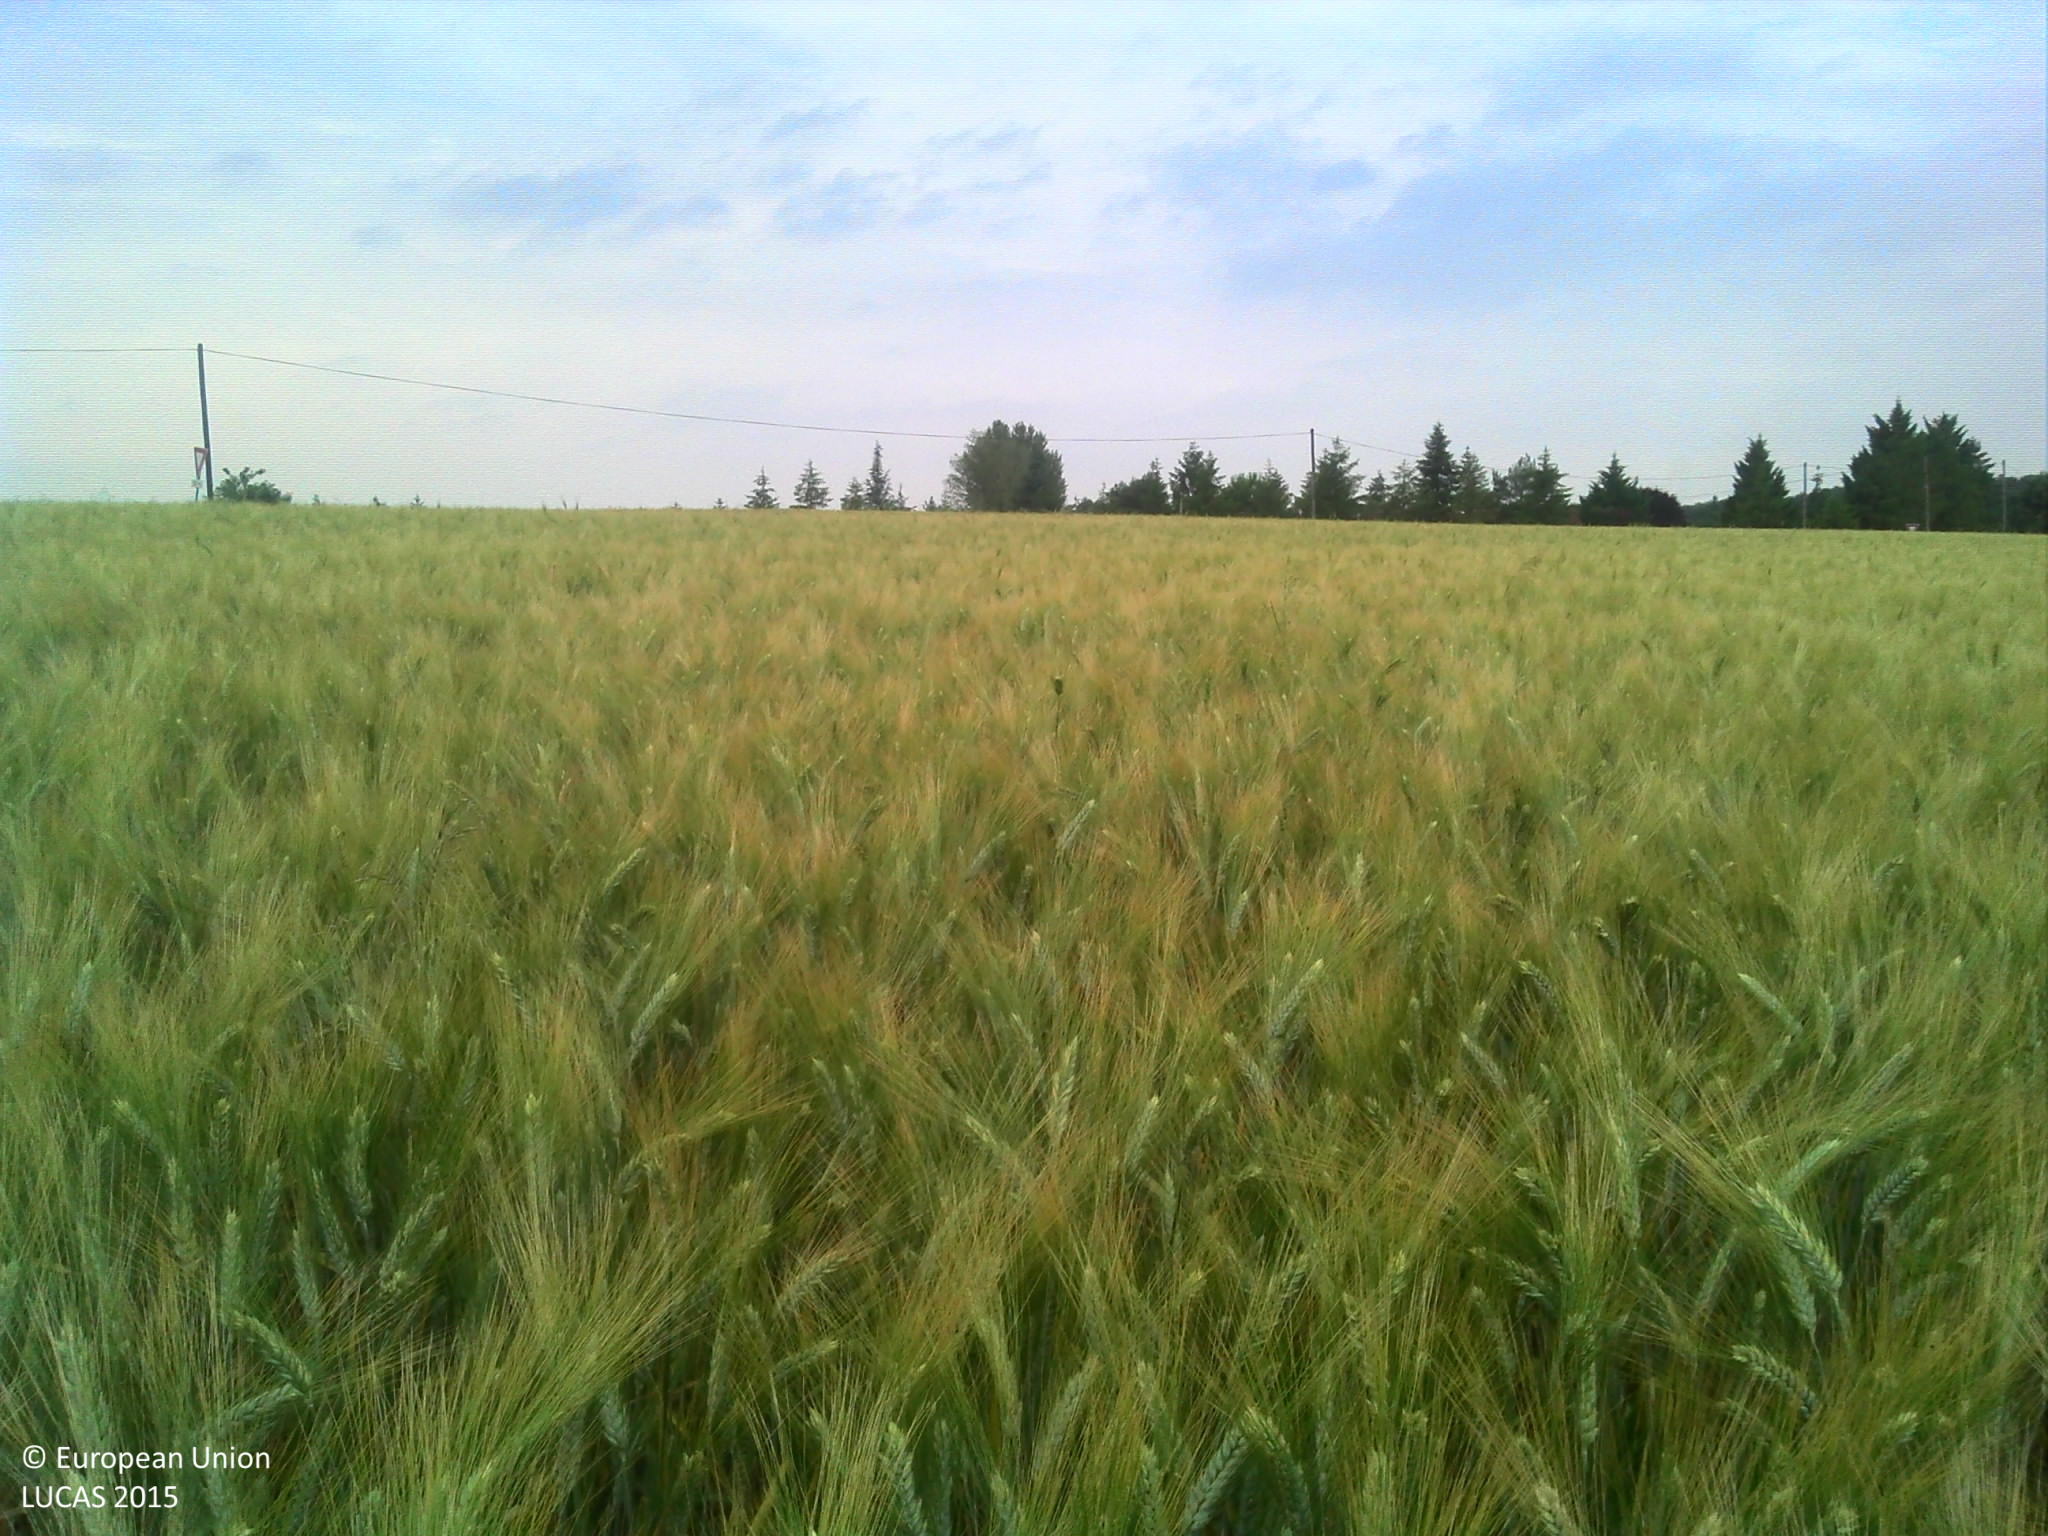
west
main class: Cropland
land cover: Common wheat
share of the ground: > 75 %
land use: Agriculture (excluding fallow land and kitchen gardens)
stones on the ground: 10 - 25 %
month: June
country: FR
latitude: 43.6888
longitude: 2.1270
